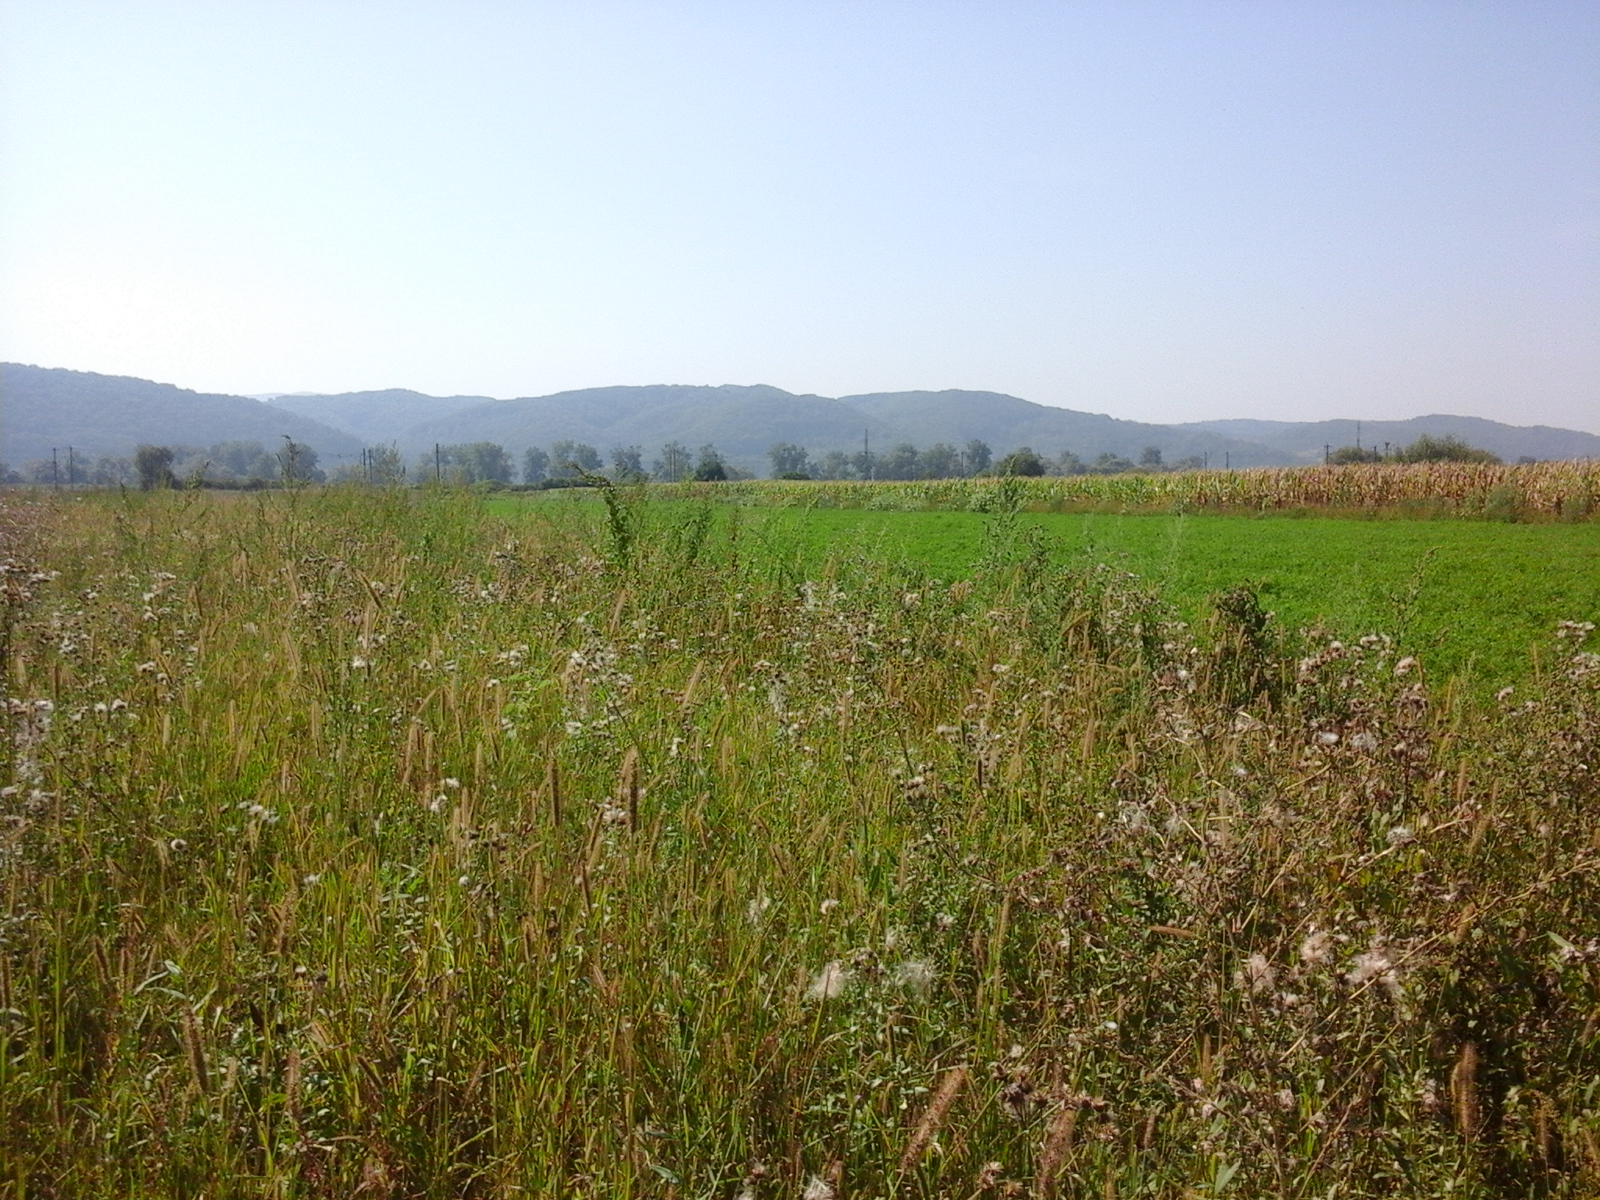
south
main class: Grassland
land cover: Spontaneously vegetated surfaces
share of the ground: > 75 %
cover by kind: herbaceous plants 100 %
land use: Agriculture (excluding fallow land and kitchen gardens)
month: August
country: RO
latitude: 45.9395
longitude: 22.6783
